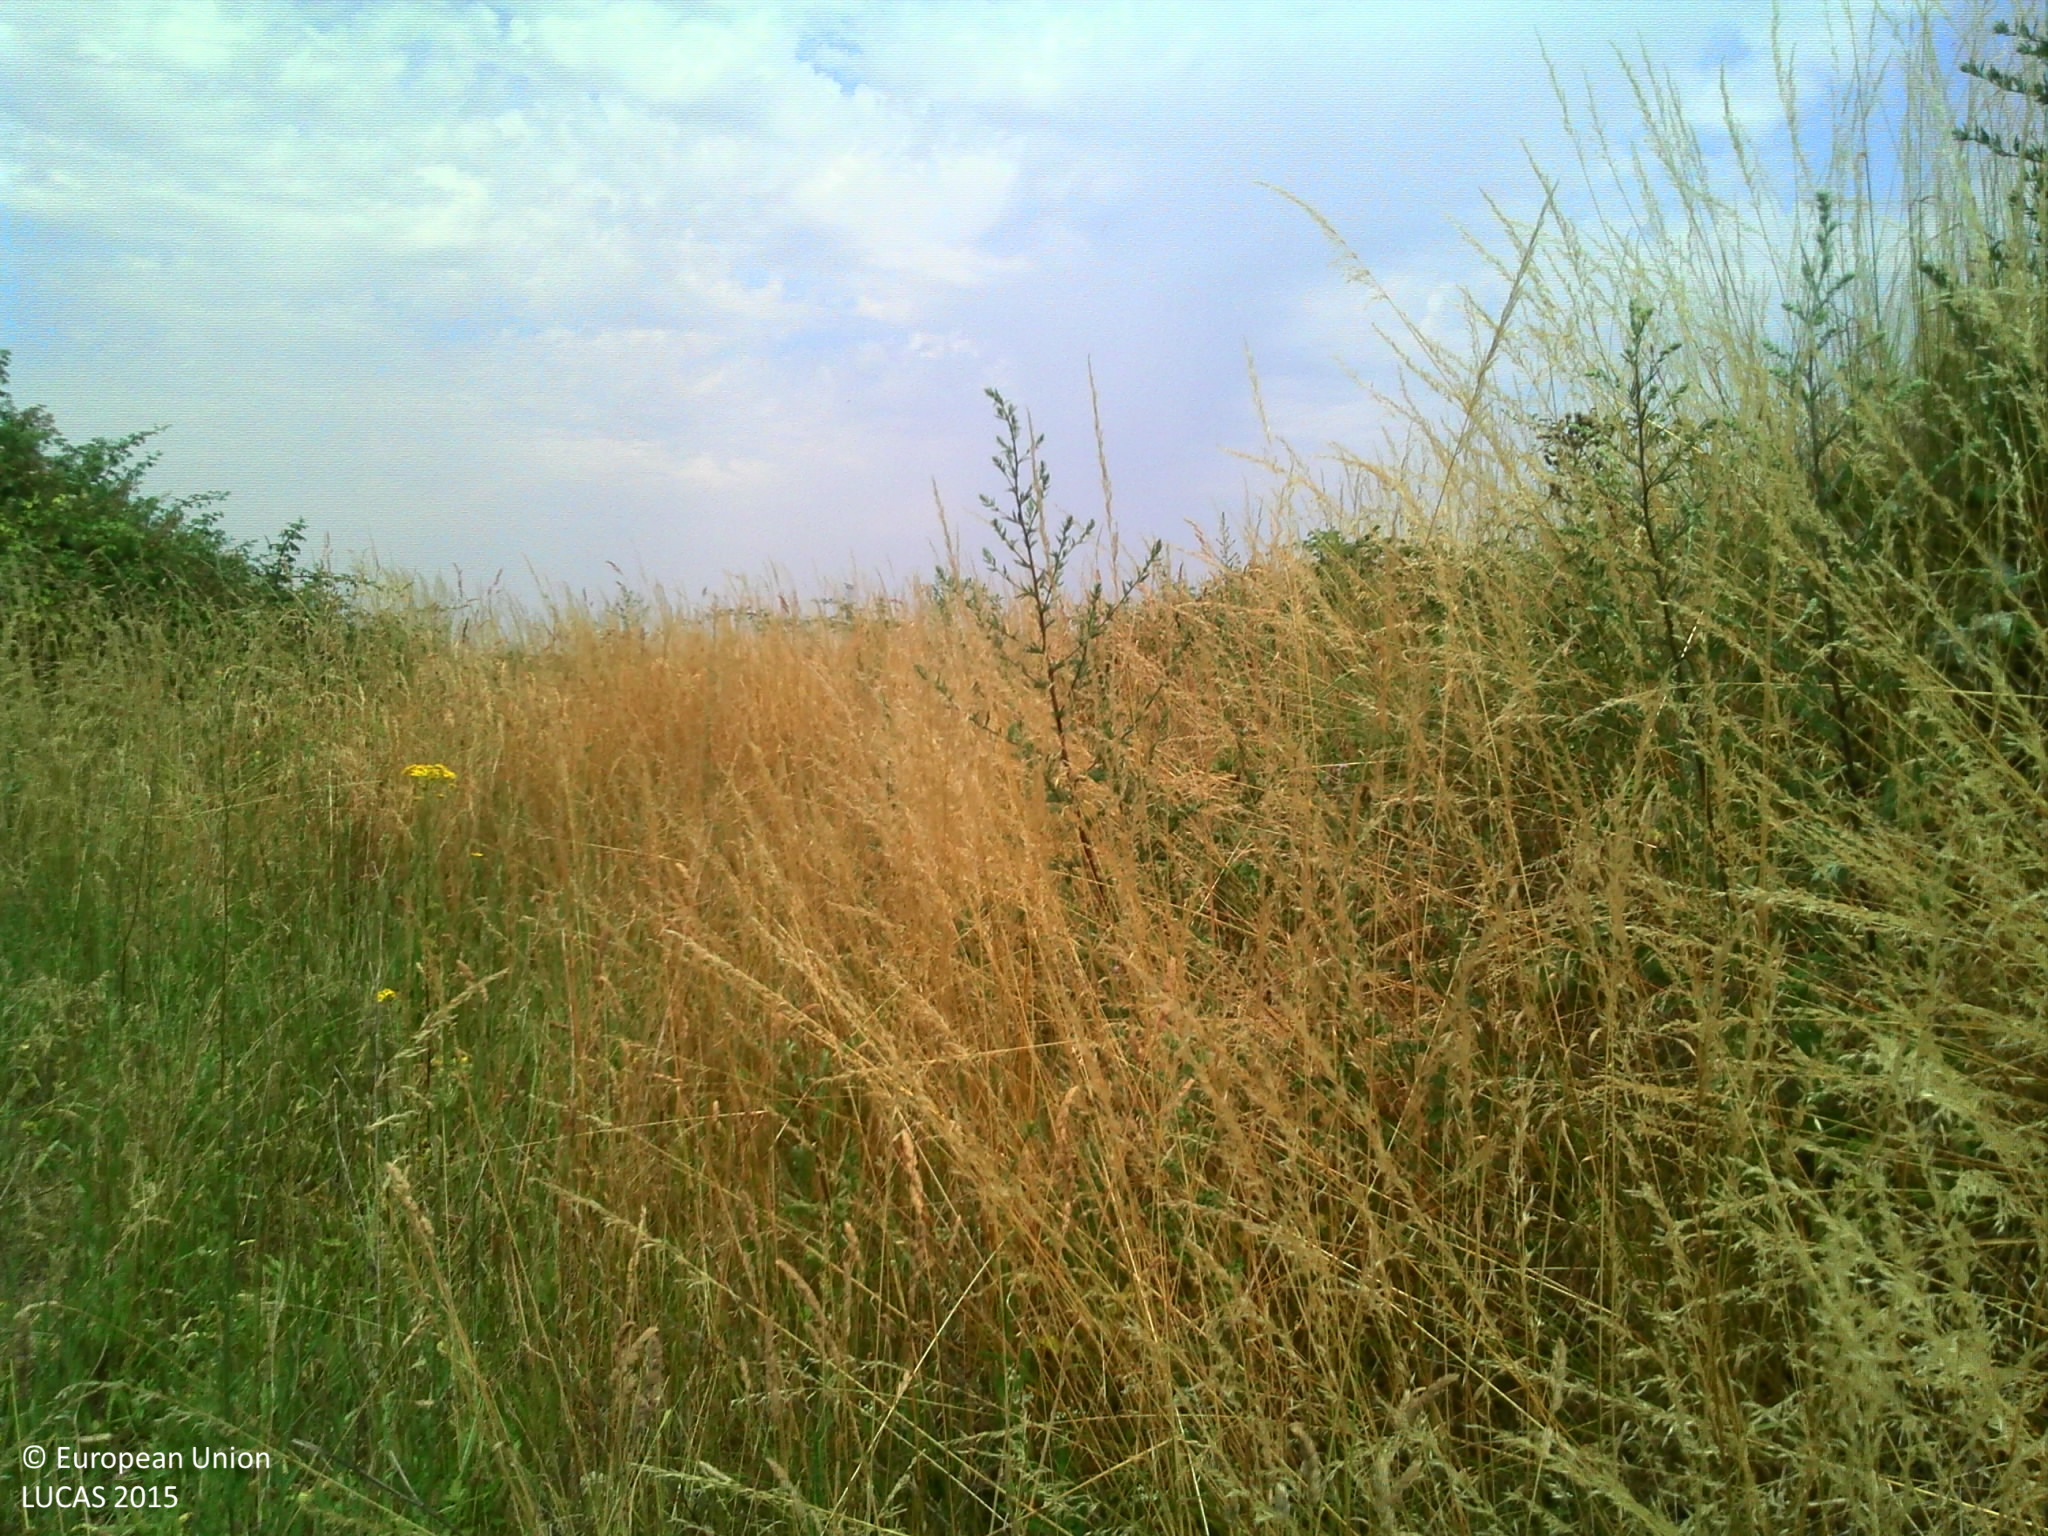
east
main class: Grassland
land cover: Spontaneously vegetated surfaces
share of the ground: > 75 %
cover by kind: herbaceous plants 100 %
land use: Mining and quarrying
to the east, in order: Spontaneously vegetated surfaces; Grassland without tree/shrub cover; Sugar beet
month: July
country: FR
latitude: 47.8965
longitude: 2.7826
